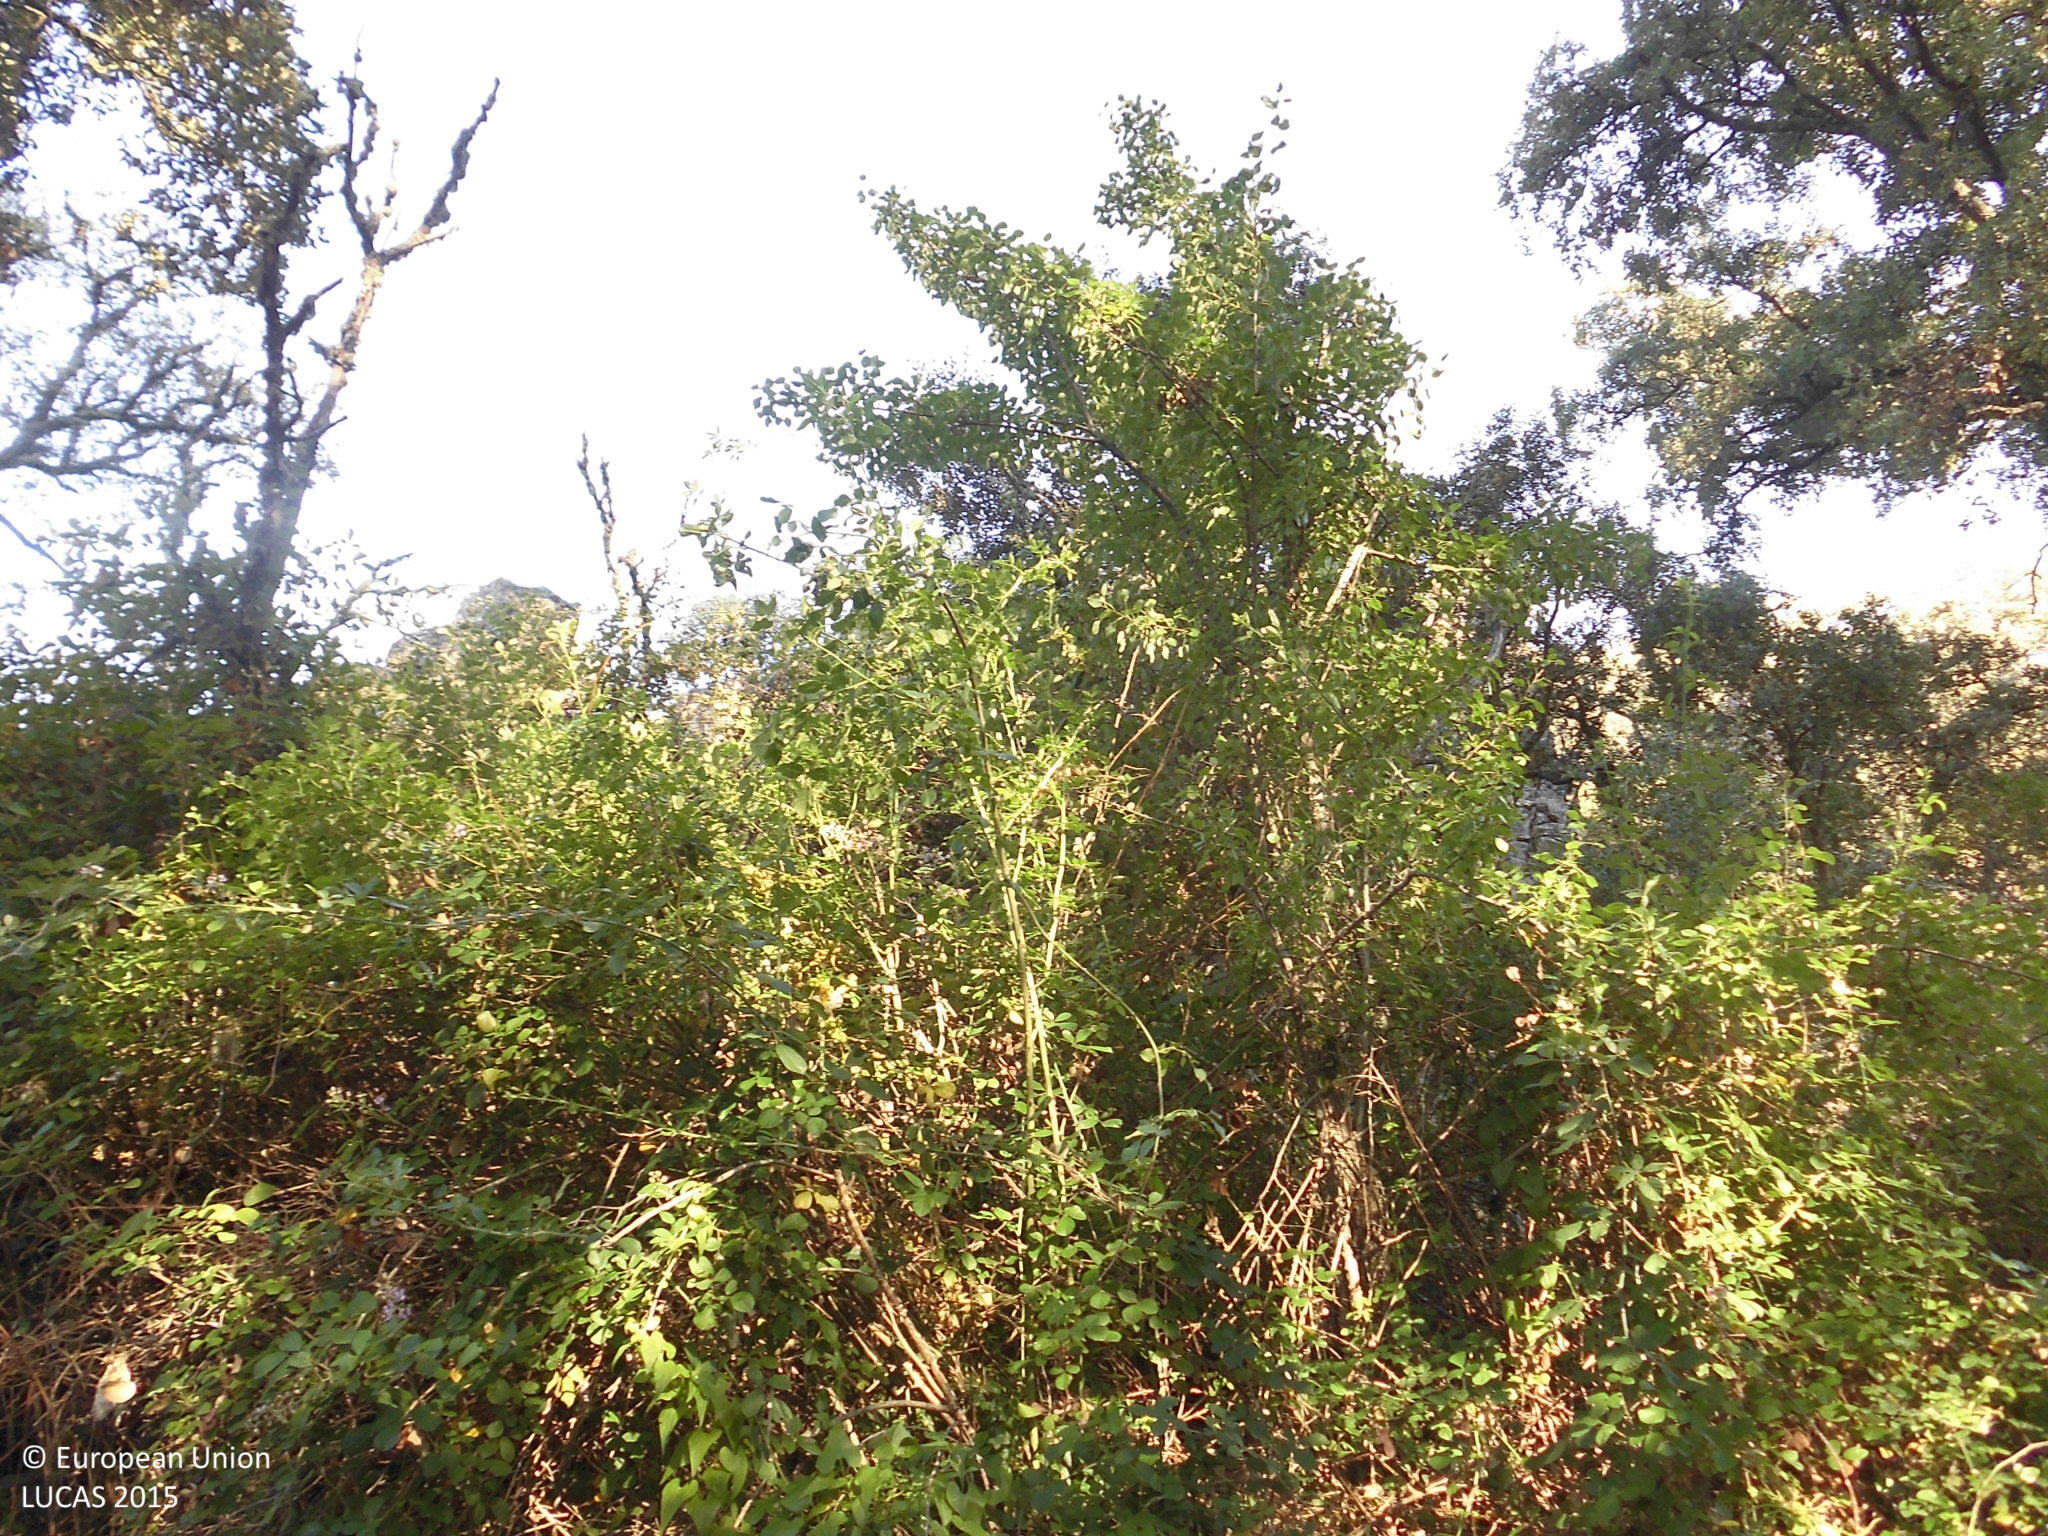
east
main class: Shrubland
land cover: Shrubland with sparse tree cover
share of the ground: > 75 %
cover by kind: shrubs 90 %, broadleaved forest trees 5 %, herbaceous plants 5 %
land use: Semi-natural and natural areas not in use
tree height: > 5 m
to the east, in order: Shrubland with sparse tree cover; Tracks; Shrubland without tree cover; Tracks; Shrubland with sparse tree cover; Shruby margins; Rivers and streams; Shrubland with sparse tree cover
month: June
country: ES
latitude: 39.6534
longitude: -5.3780
